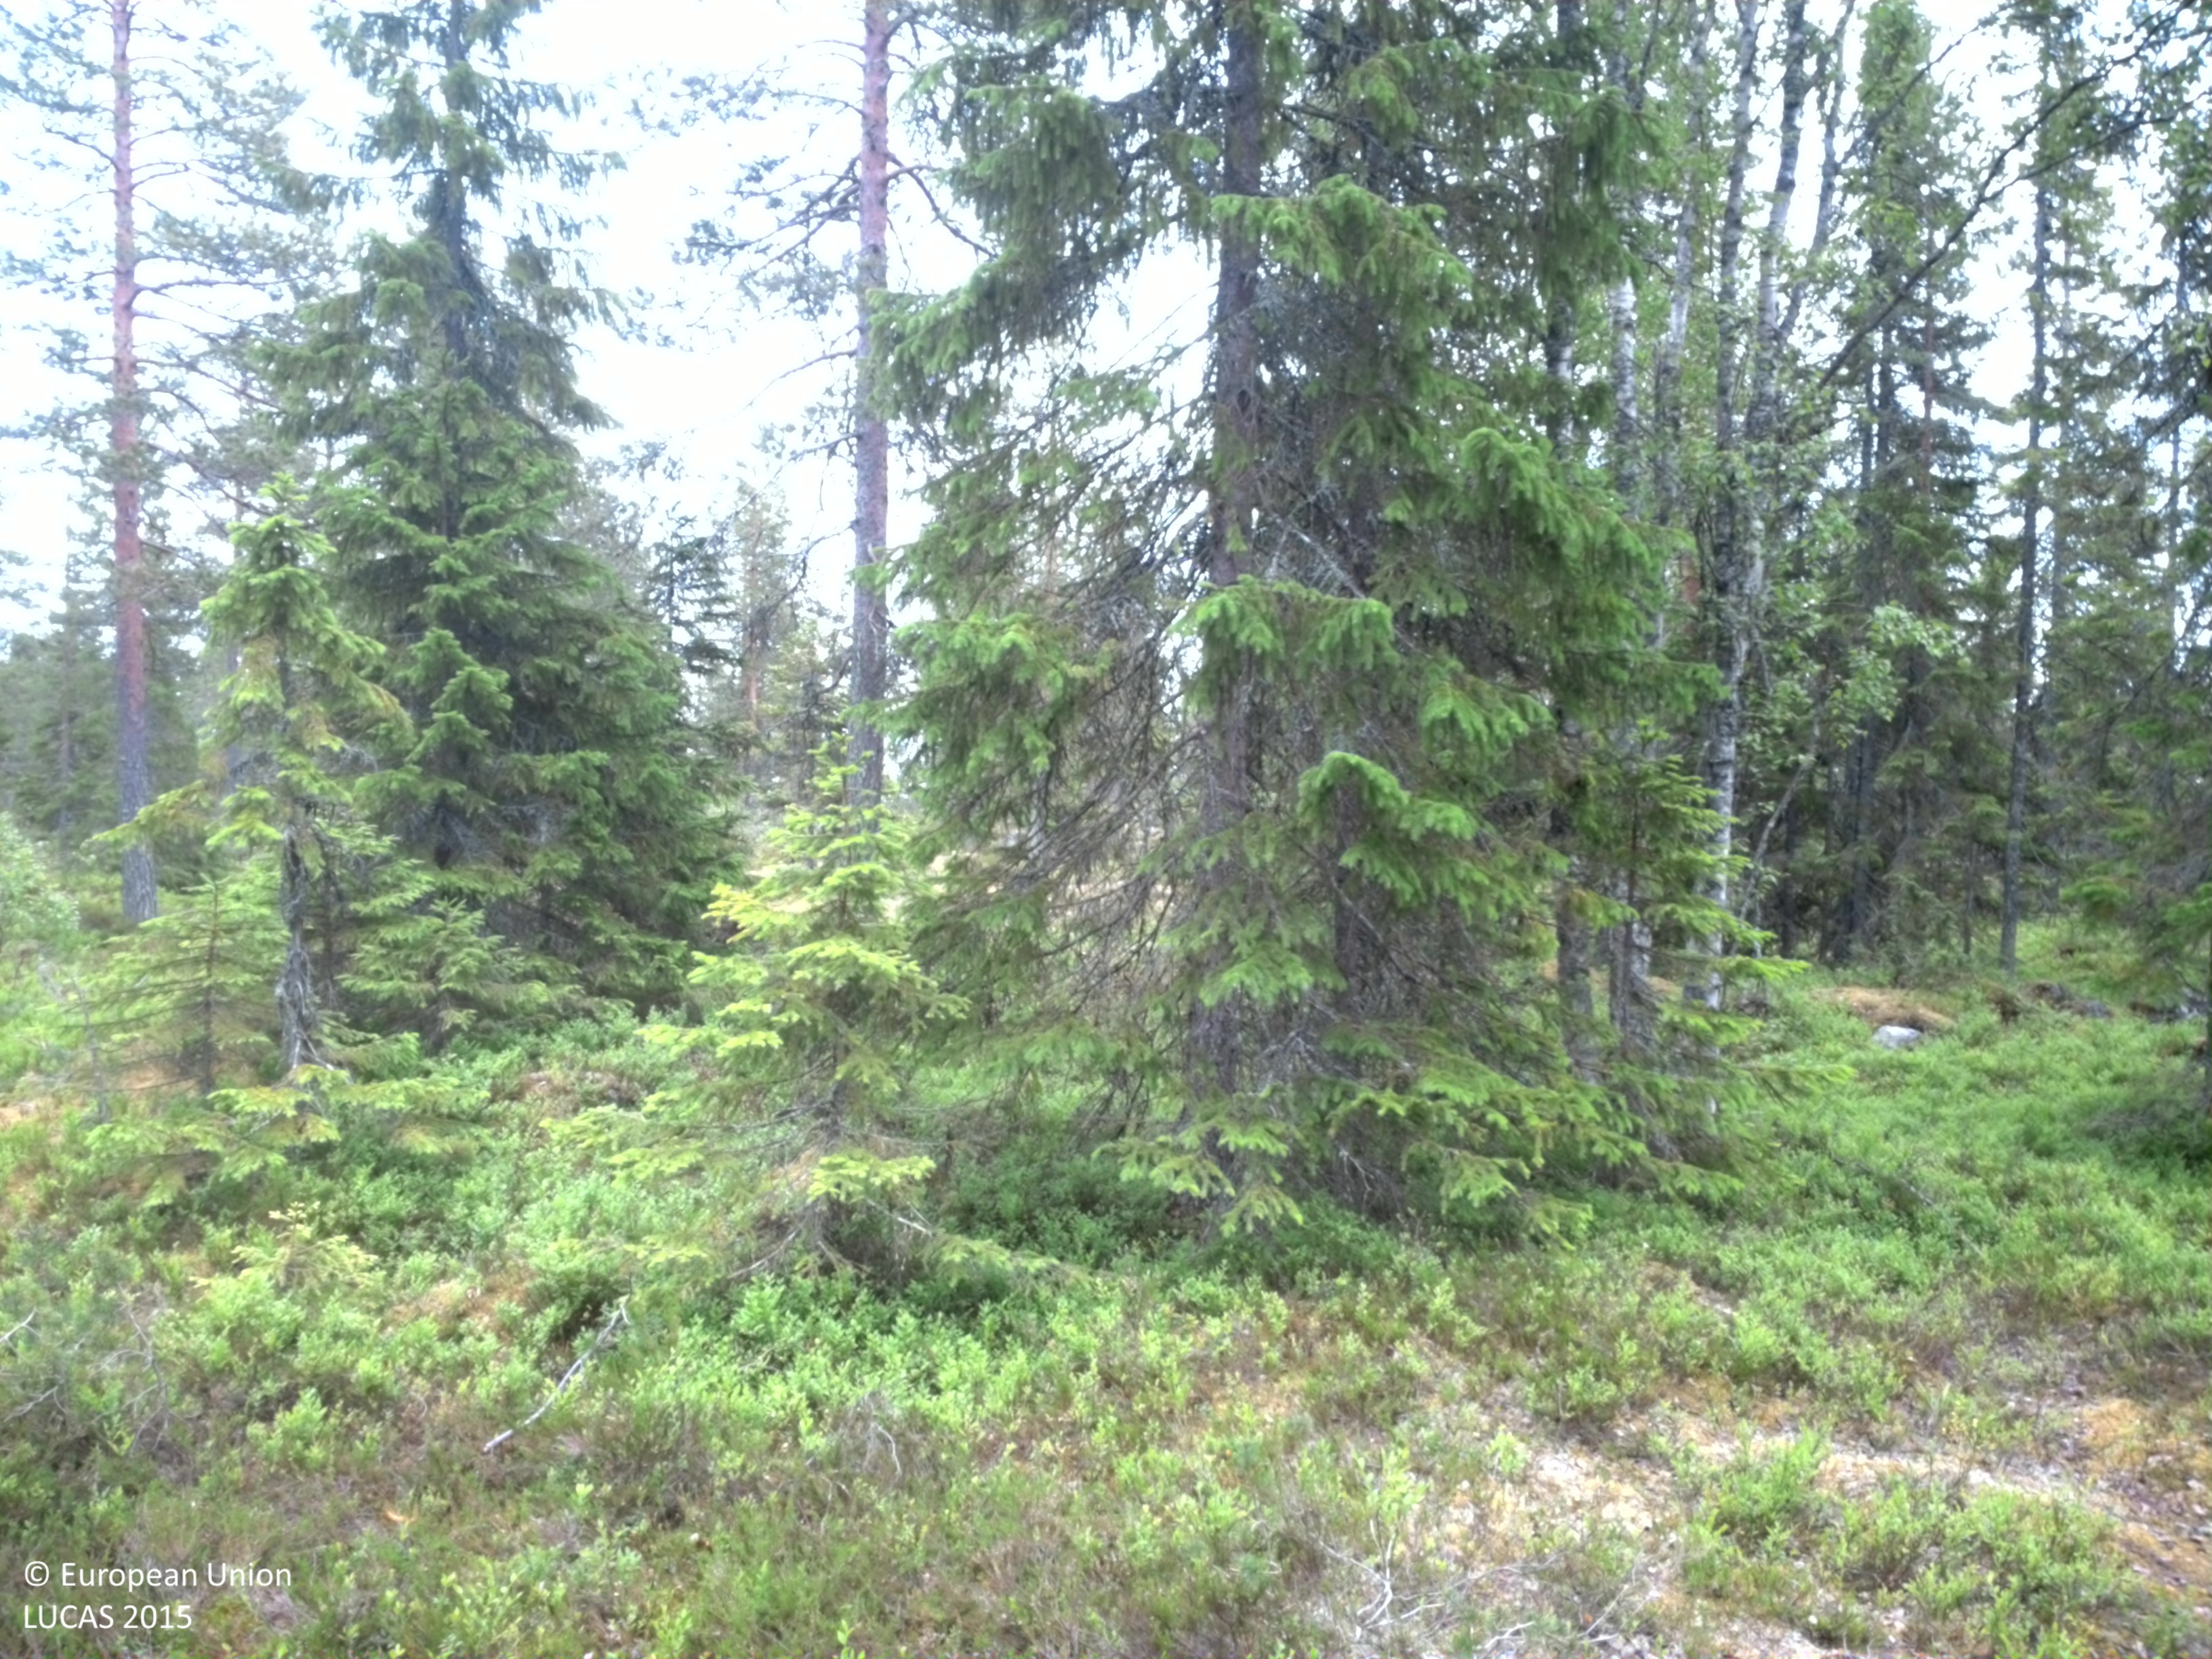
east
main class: Woodland
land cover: Other coniferous woodland
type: boreal forest
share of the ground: 25 - 50 %
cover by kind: coniferous forest trees 50 %, shrubs 45 %, lichens and mosses 5 %
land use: Forestry
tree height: > 5 m
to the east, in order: Other coniferous woodland; Pine dominated coniferous woodland
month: July
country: SE
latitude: 64.3744
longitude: 20.8191
